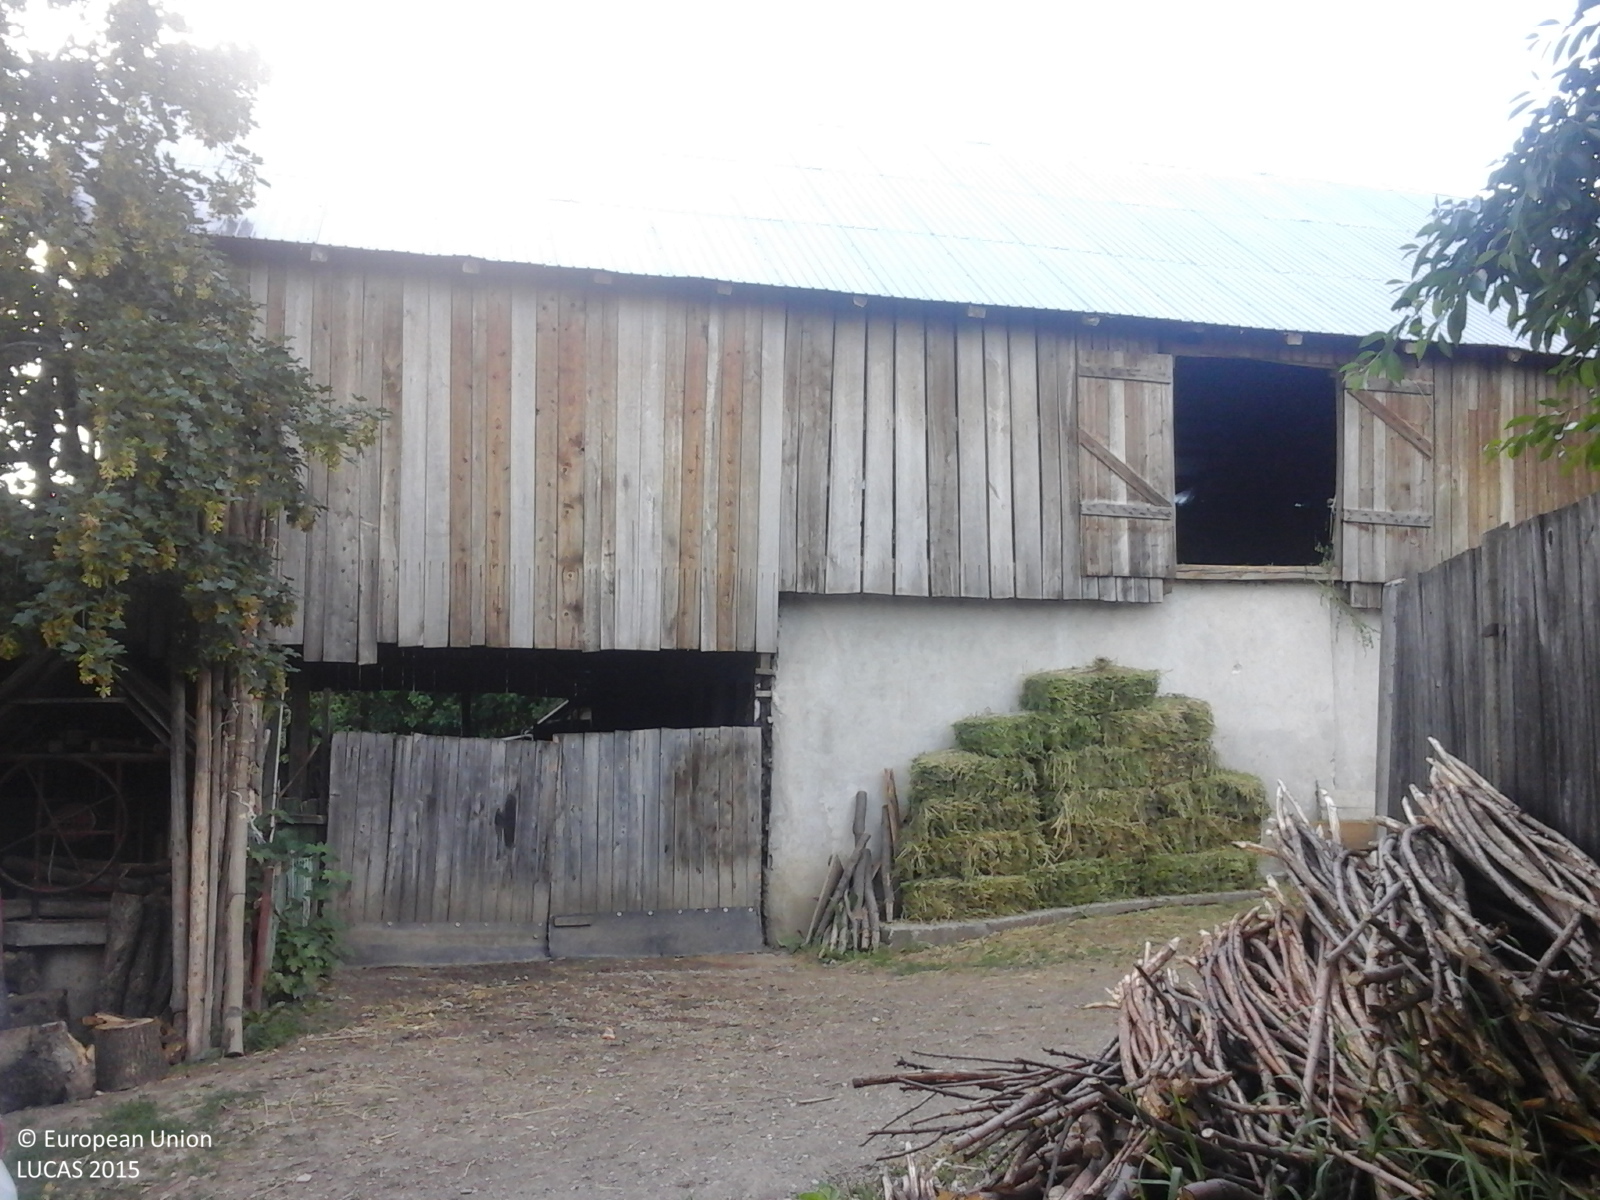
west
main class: Cropland
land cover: Other fresh vegetables
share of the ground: < 10 %
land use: Kitchen garden
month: June
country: RO
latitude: 46.4292
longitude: 26.8926
